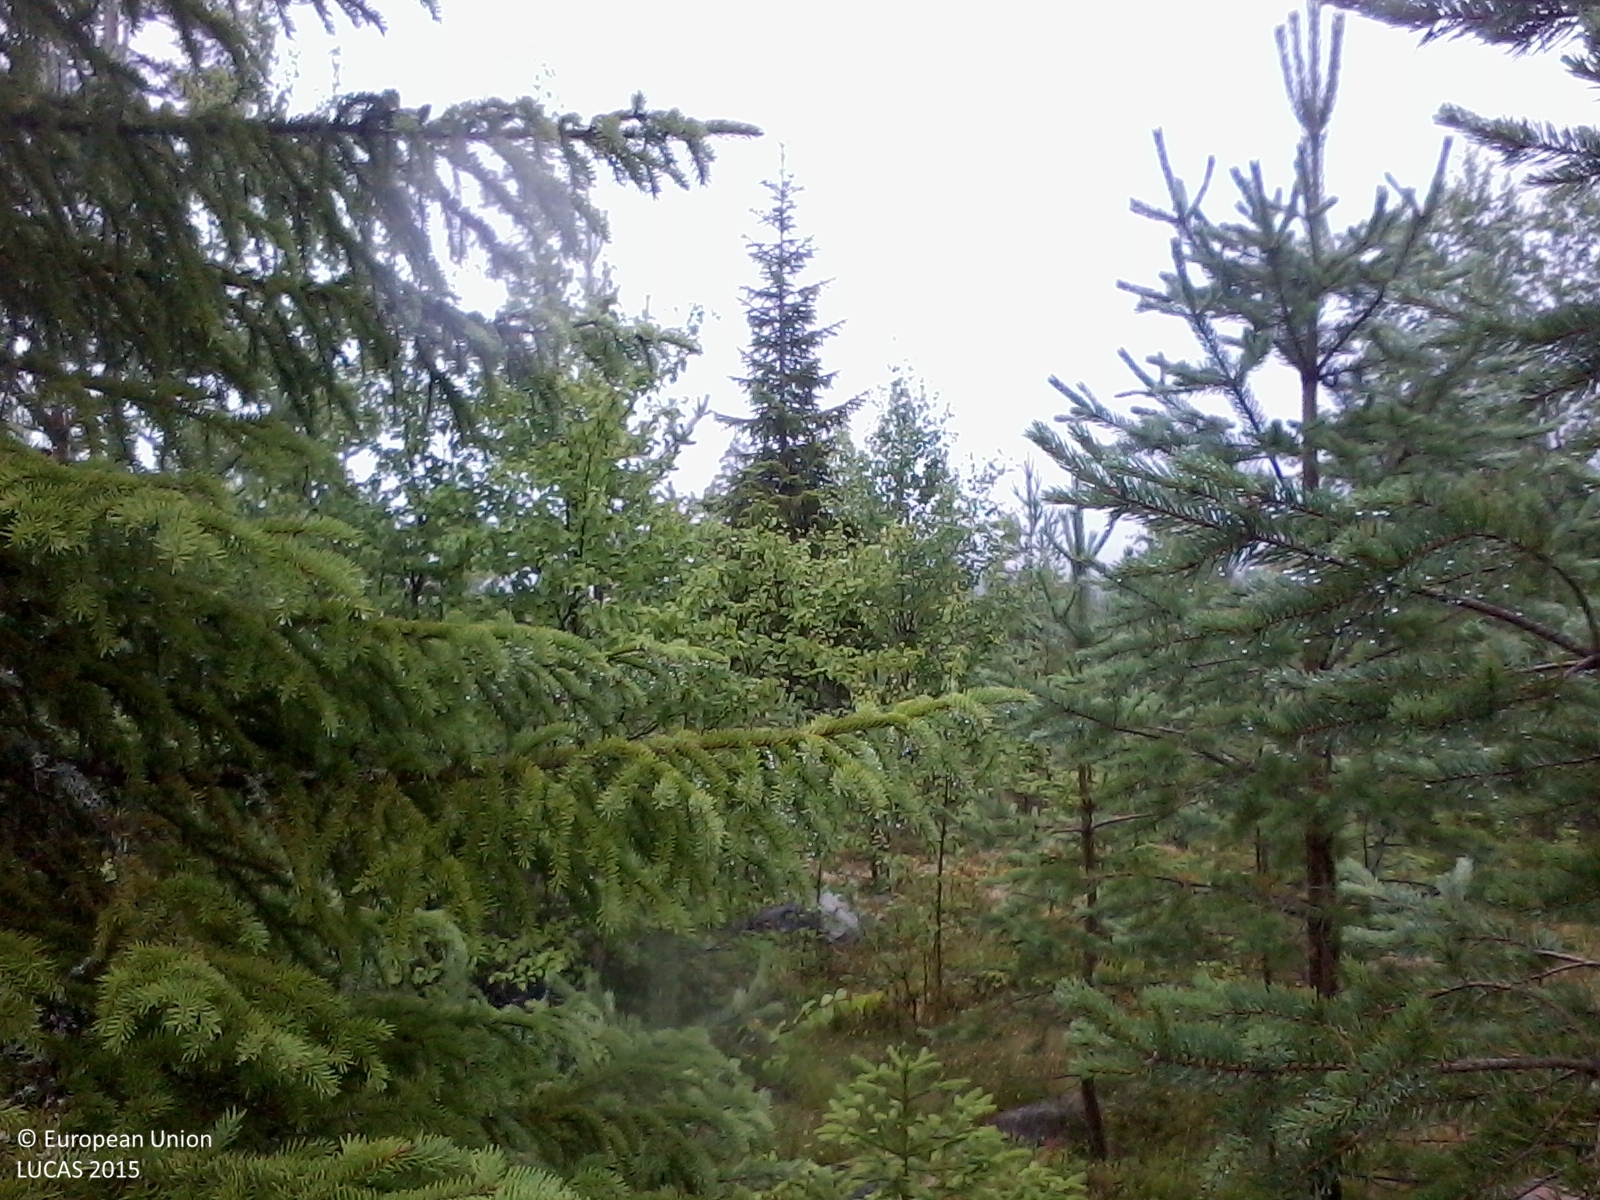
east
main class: Woodland
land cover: Pine dominated mixed woodland
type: boreal forest
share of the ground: 50 - 75 %
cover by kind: coniferous forest trees 40 %, shrubs 25 %, lichens and mosses 20 %, broadleaved forest trees 15 %
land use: Forestry
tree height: < 5 m
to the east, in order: Pine dominated mixed woodland; Spruce dominated mixed woodland; Ditches and canals; Paved roads, cycling and walking lanes; Spruce dominated mixed woodland; Inland fresh water bodies
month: August
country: SE
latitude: 62.8914
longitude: 16.8422
